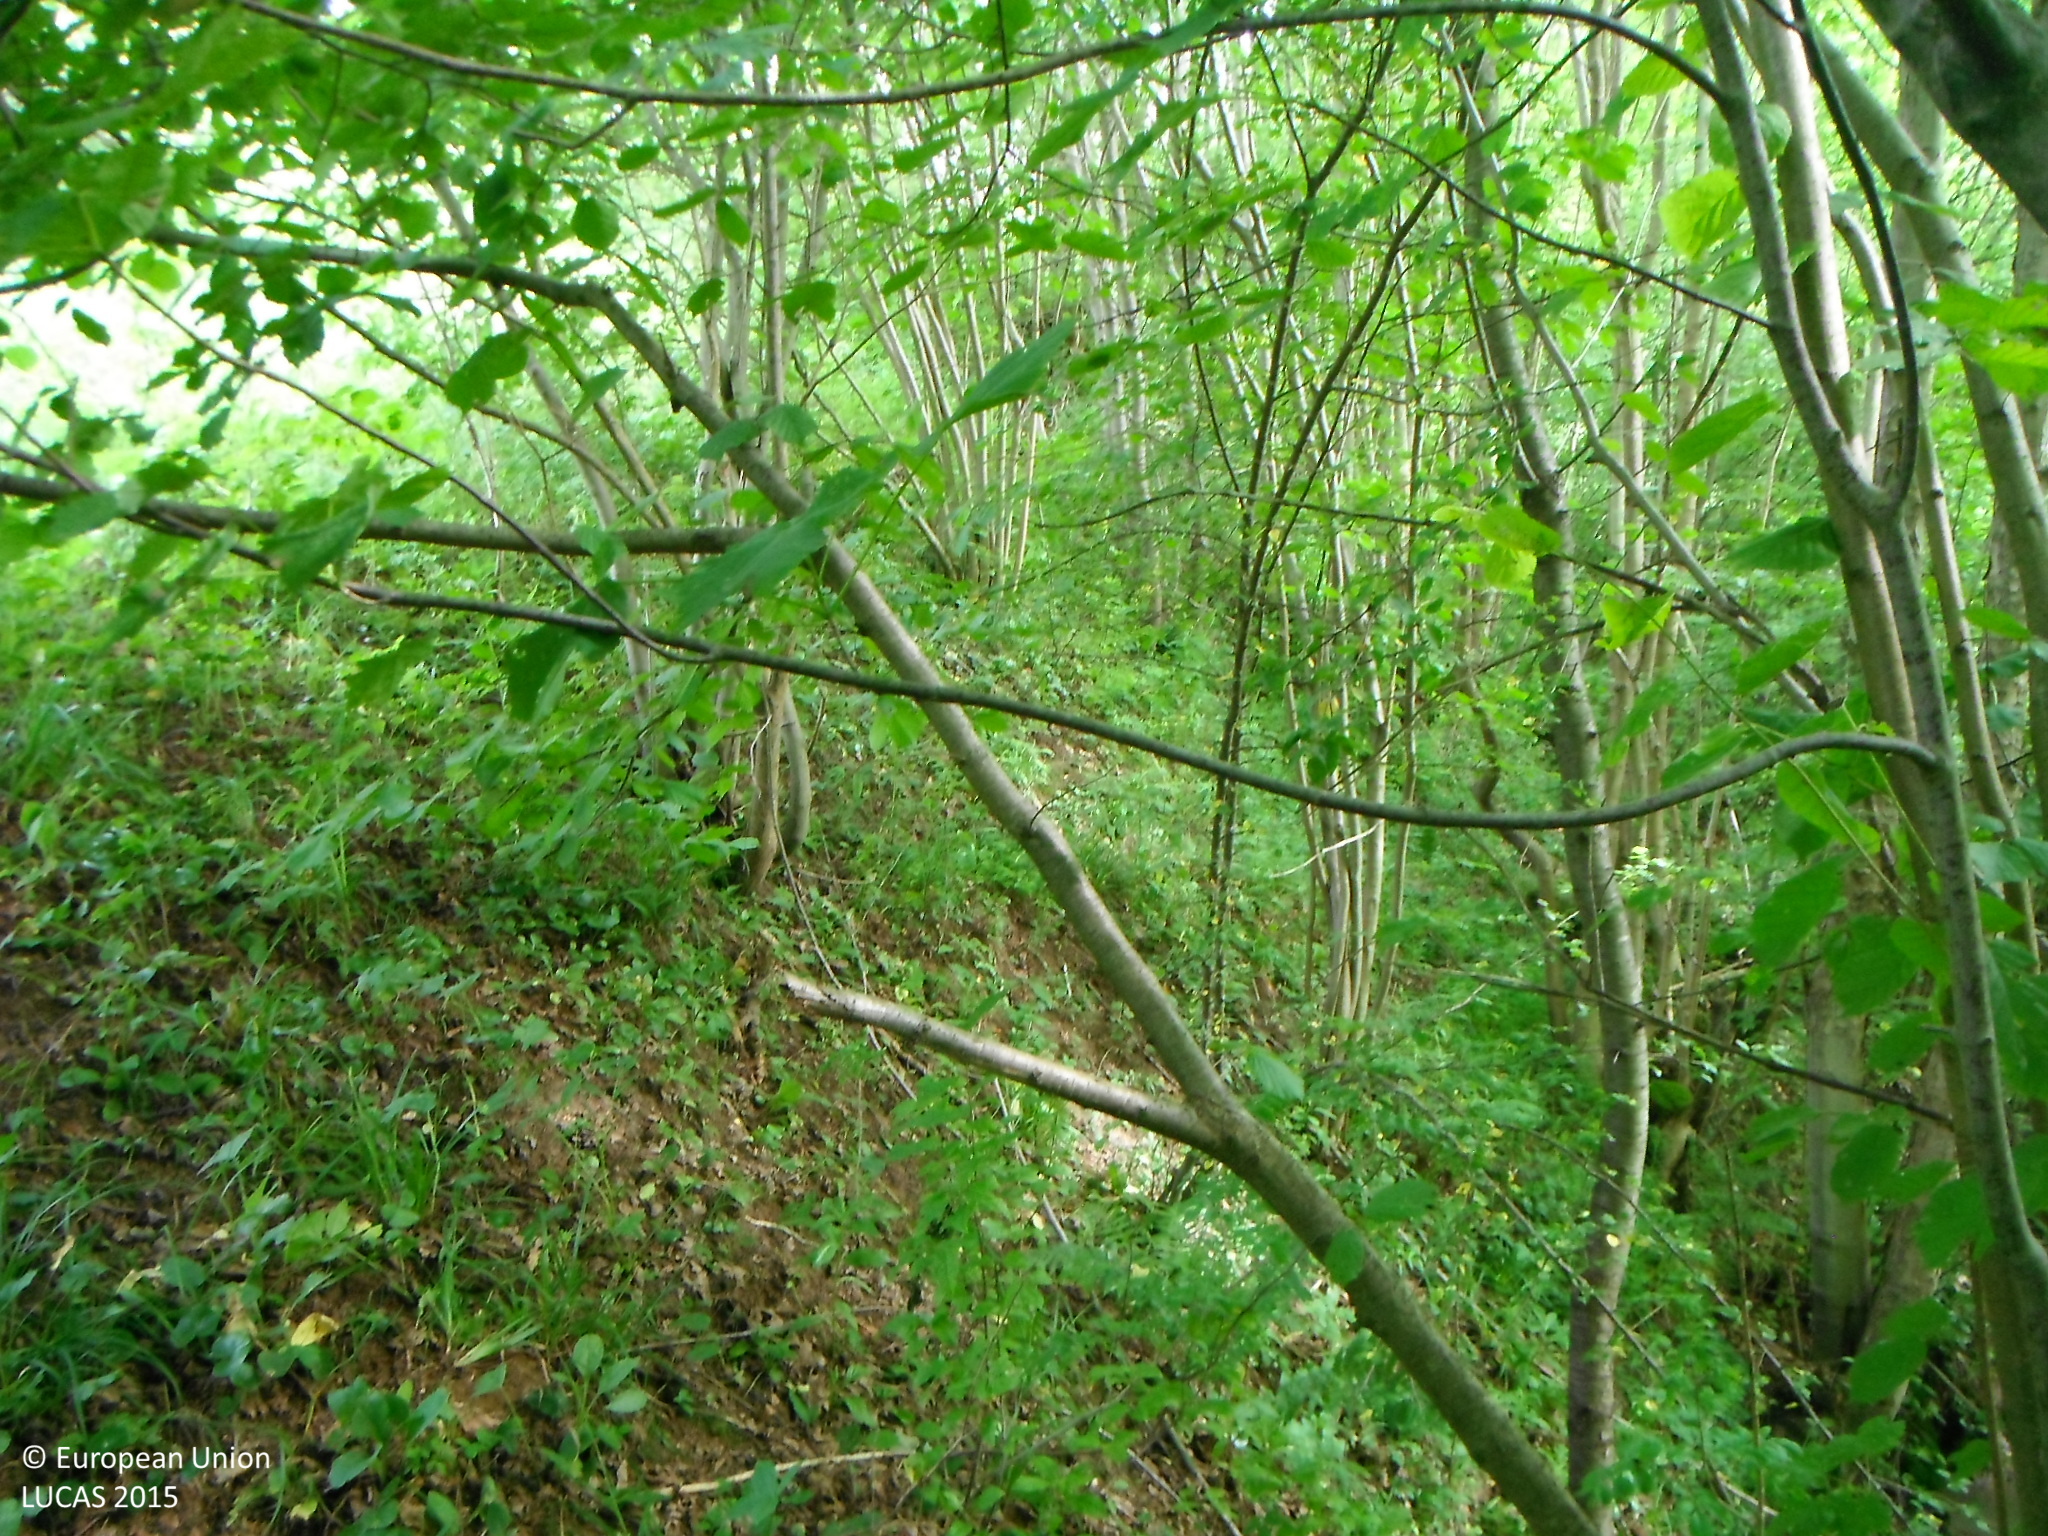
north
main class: Woodland
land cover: Broadleaved woodland
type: mesophytic deciduous forest
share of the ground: > 75 %
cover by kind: broadleaved forest trees 100 %
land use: Semi-natural and natural areas not in use
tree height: > 5 m
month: July
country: SK
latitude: 49.2939
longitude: 19.1118
